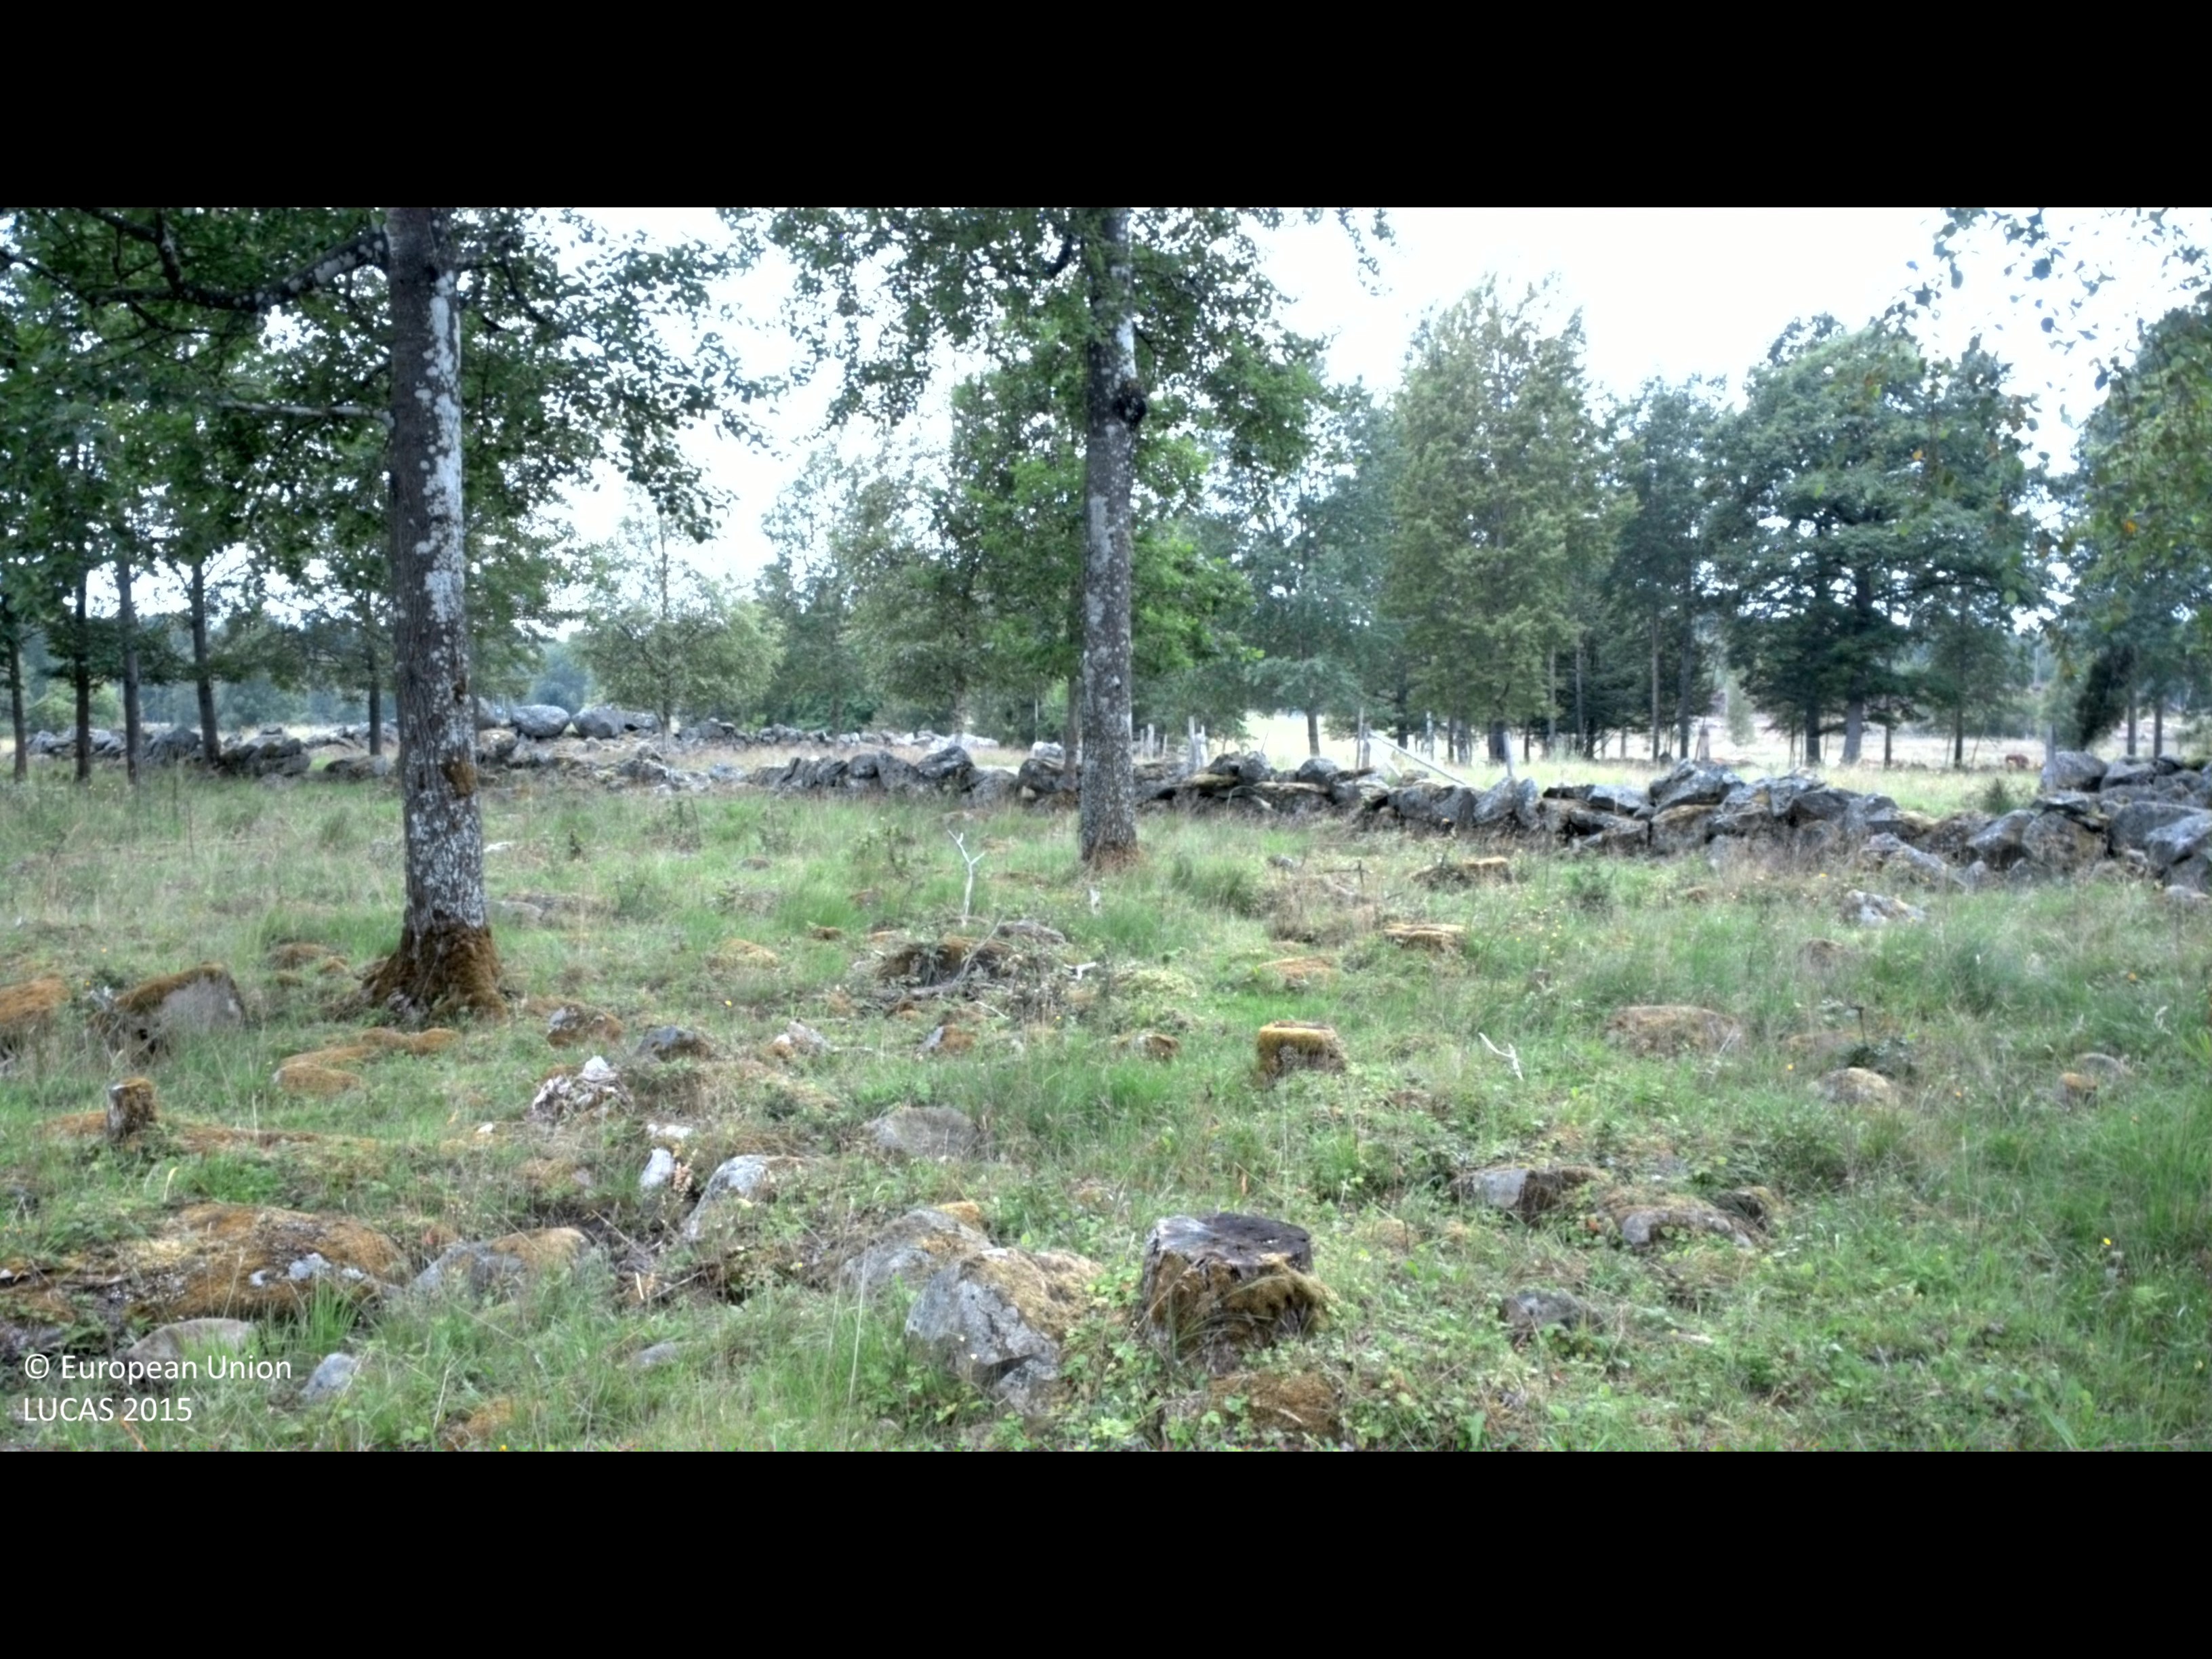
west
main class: Woodland
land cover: Broadleaved woodland
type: non-riverine alder, birch or aspen forest
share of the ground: 25 - 50 %
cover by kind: broadleaved forest trees 40 %, herbaceous plants 40 %, shrubs 10 %, consolidated bare surface 10 %
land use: Agriculture (excluding fallow land and kitchen gardens)
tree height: > 5 m
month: July
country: SE
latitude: 56.4895
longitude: 14.4312
